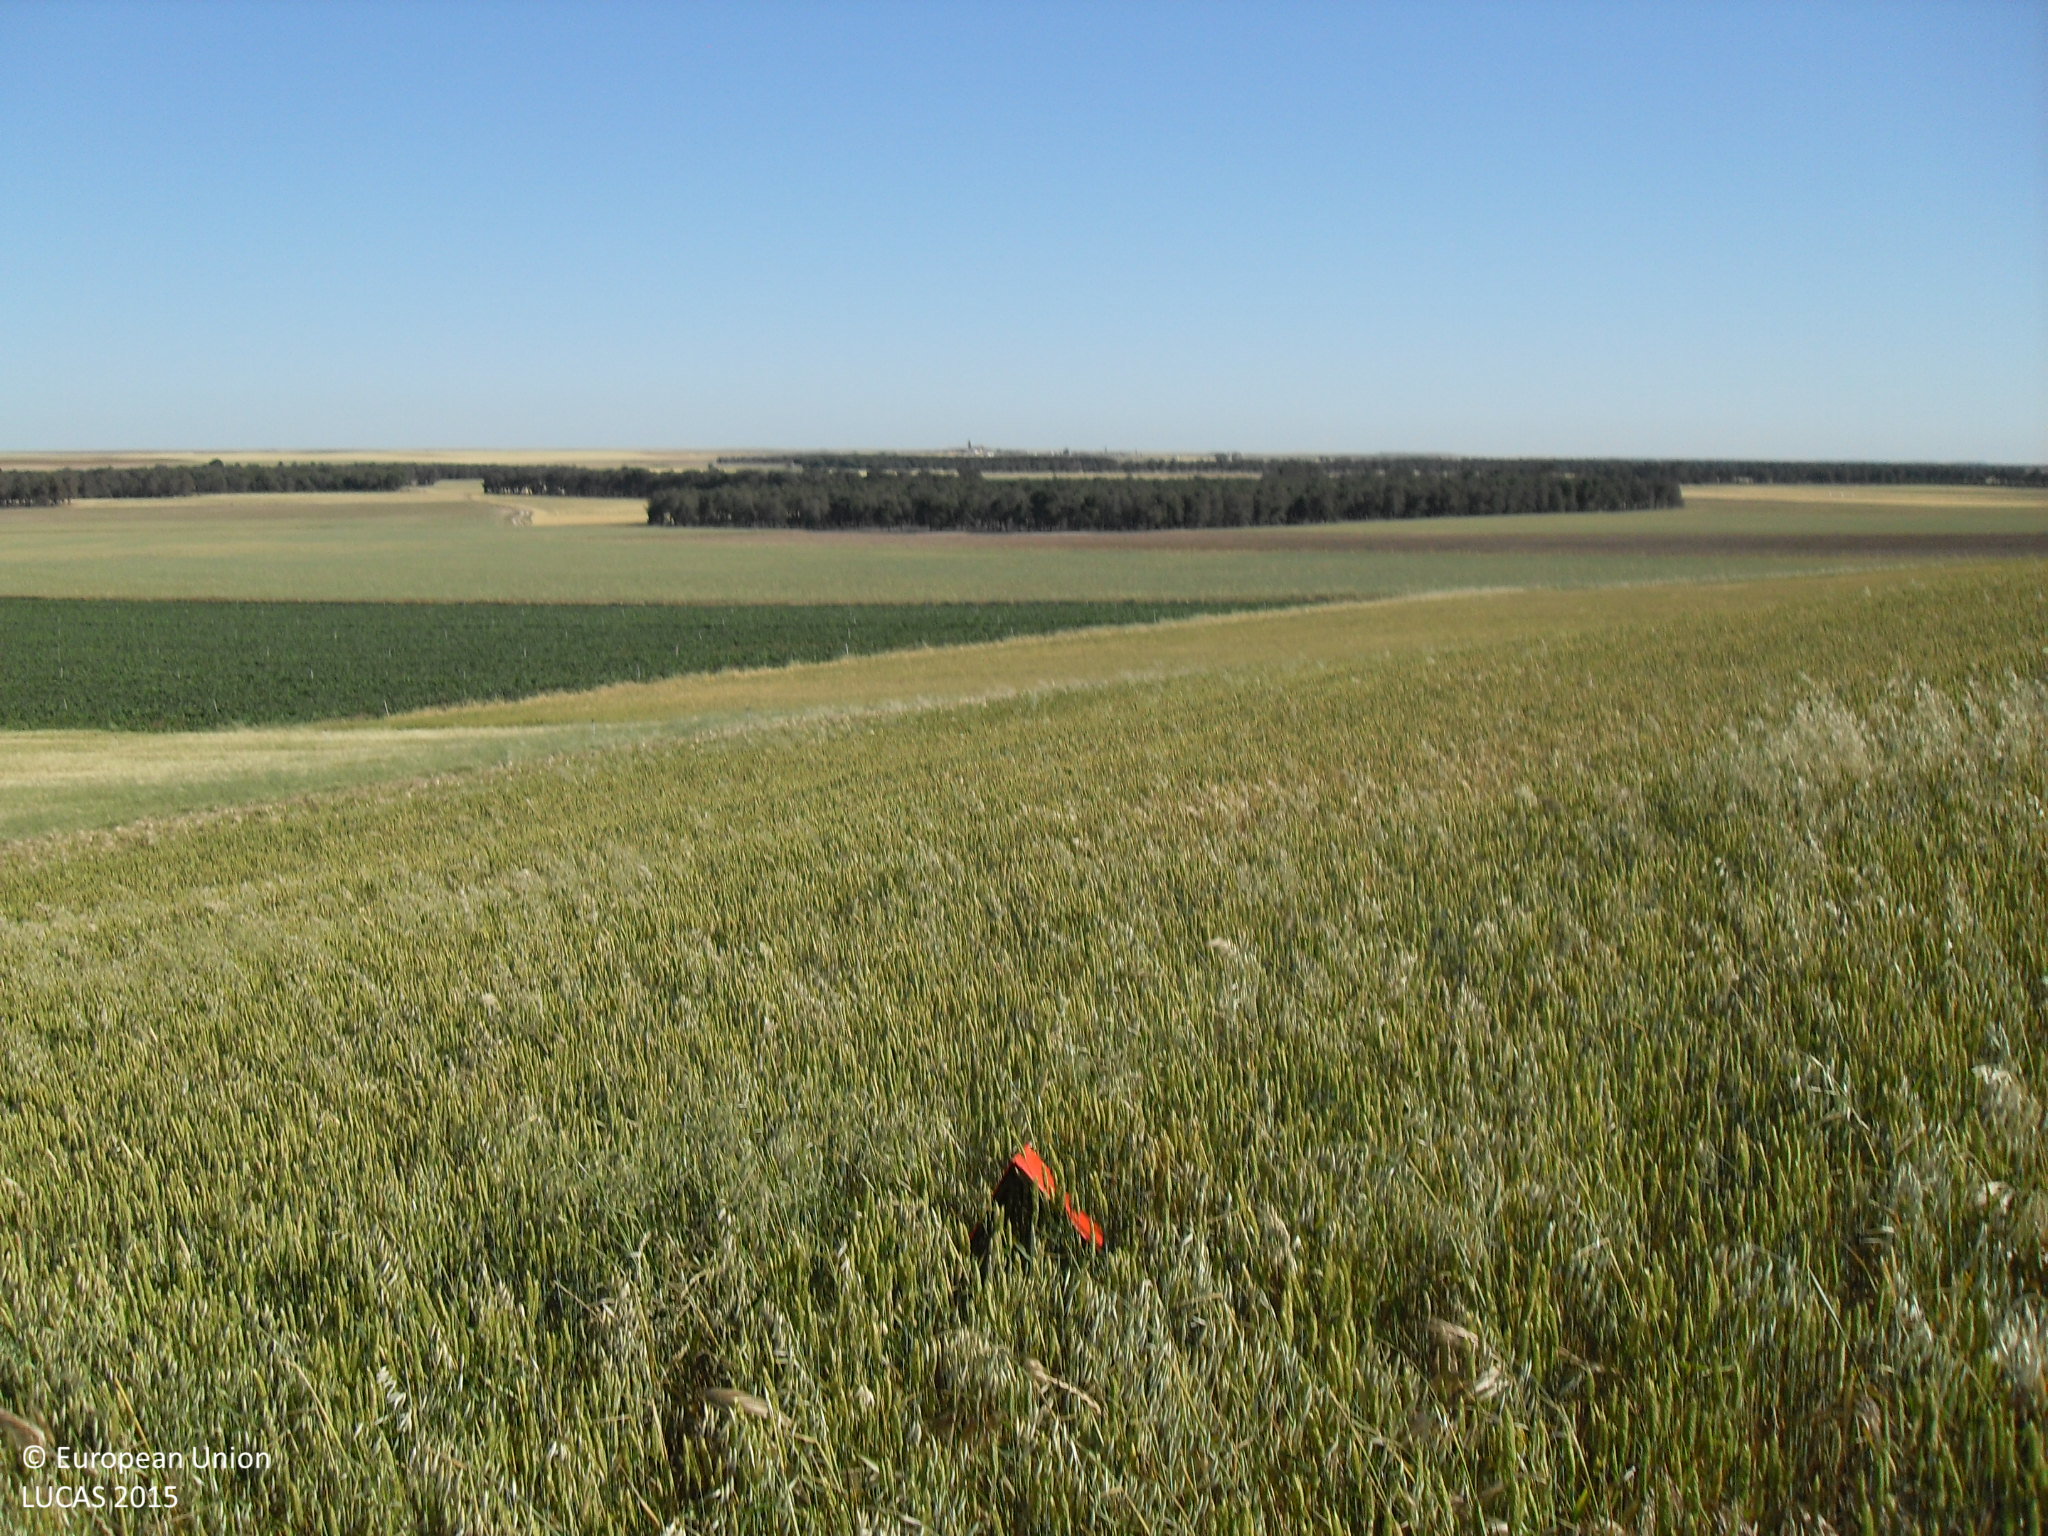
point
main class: Cropland
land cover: Common wheat
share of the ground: > 75 %
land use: Agriculture (excluding fallow land and kitchen gardens)
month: May
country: ES
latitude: 41.1657
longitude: -5.2199
